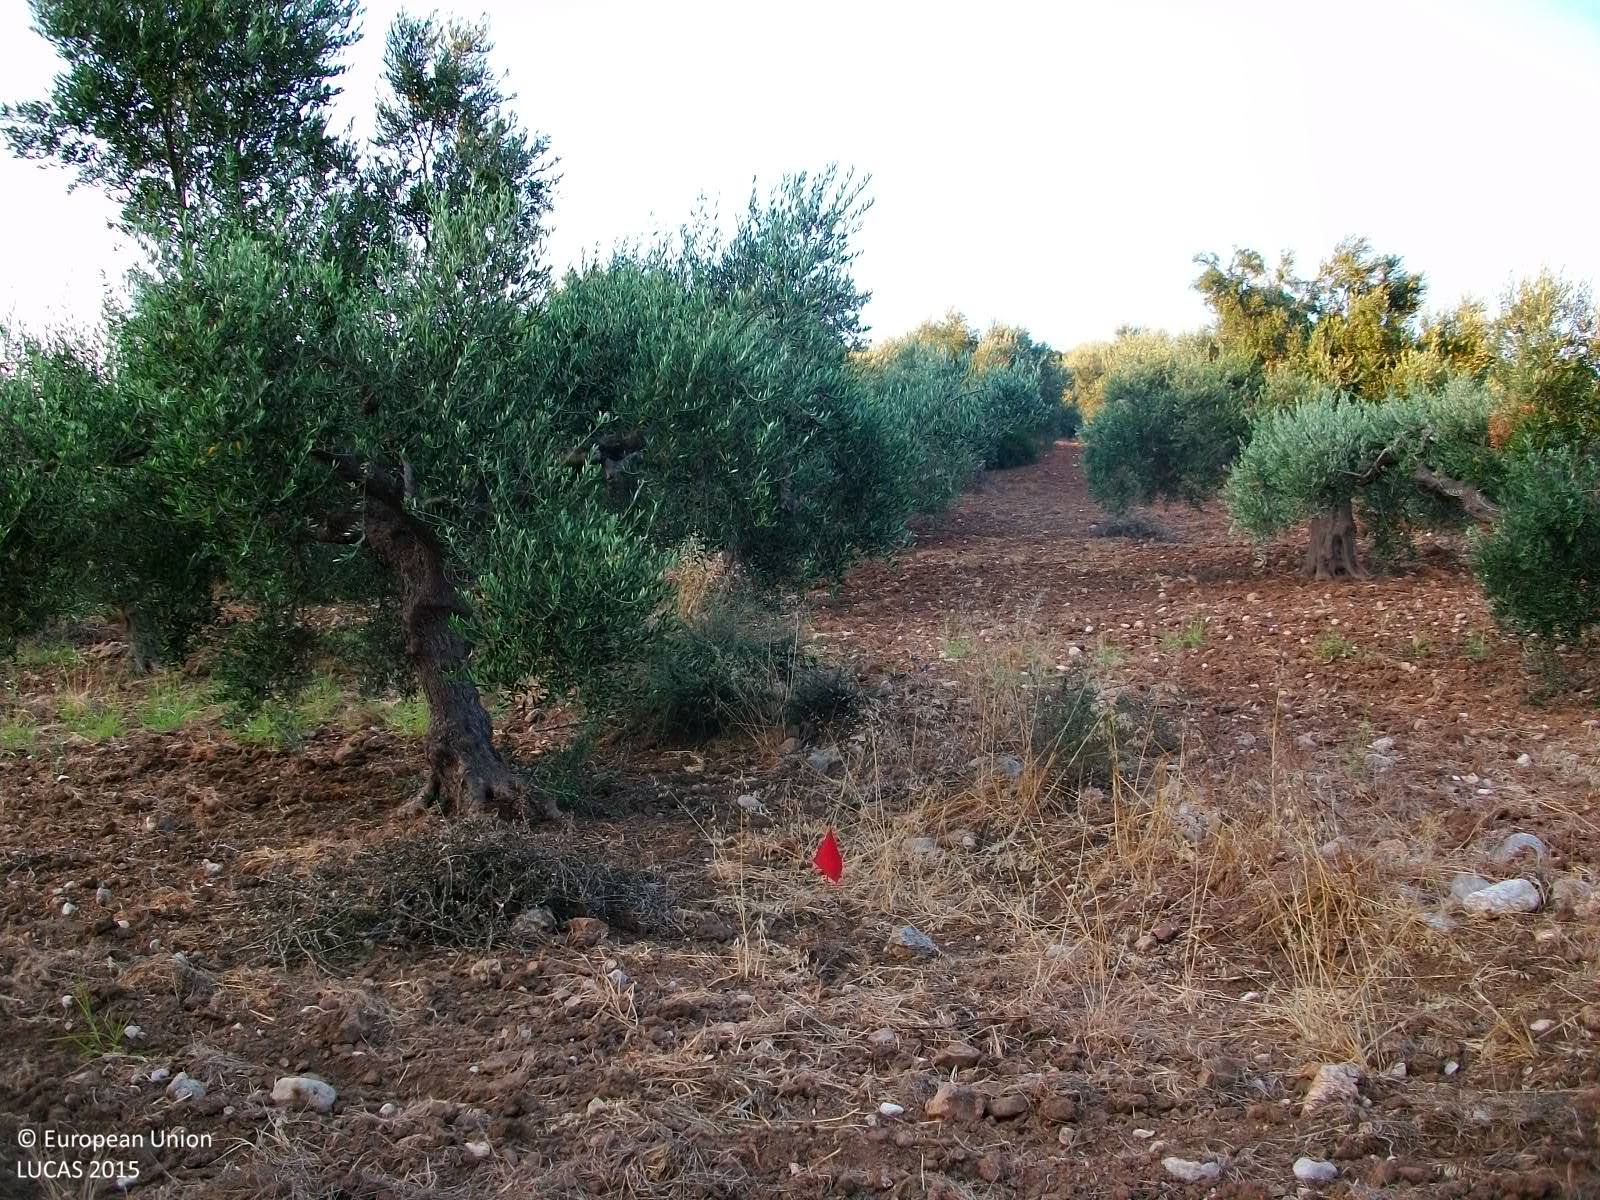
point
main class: Cropland
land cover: Olive groves
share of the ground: 25 - 50 %
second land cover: Other bare soil
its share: > 75 %
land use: Agriculture (excluding fallow land and kitchen gardens)
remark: Tilled/Sowed
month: July
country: GR
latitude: 36.7855
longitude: 21.8378
